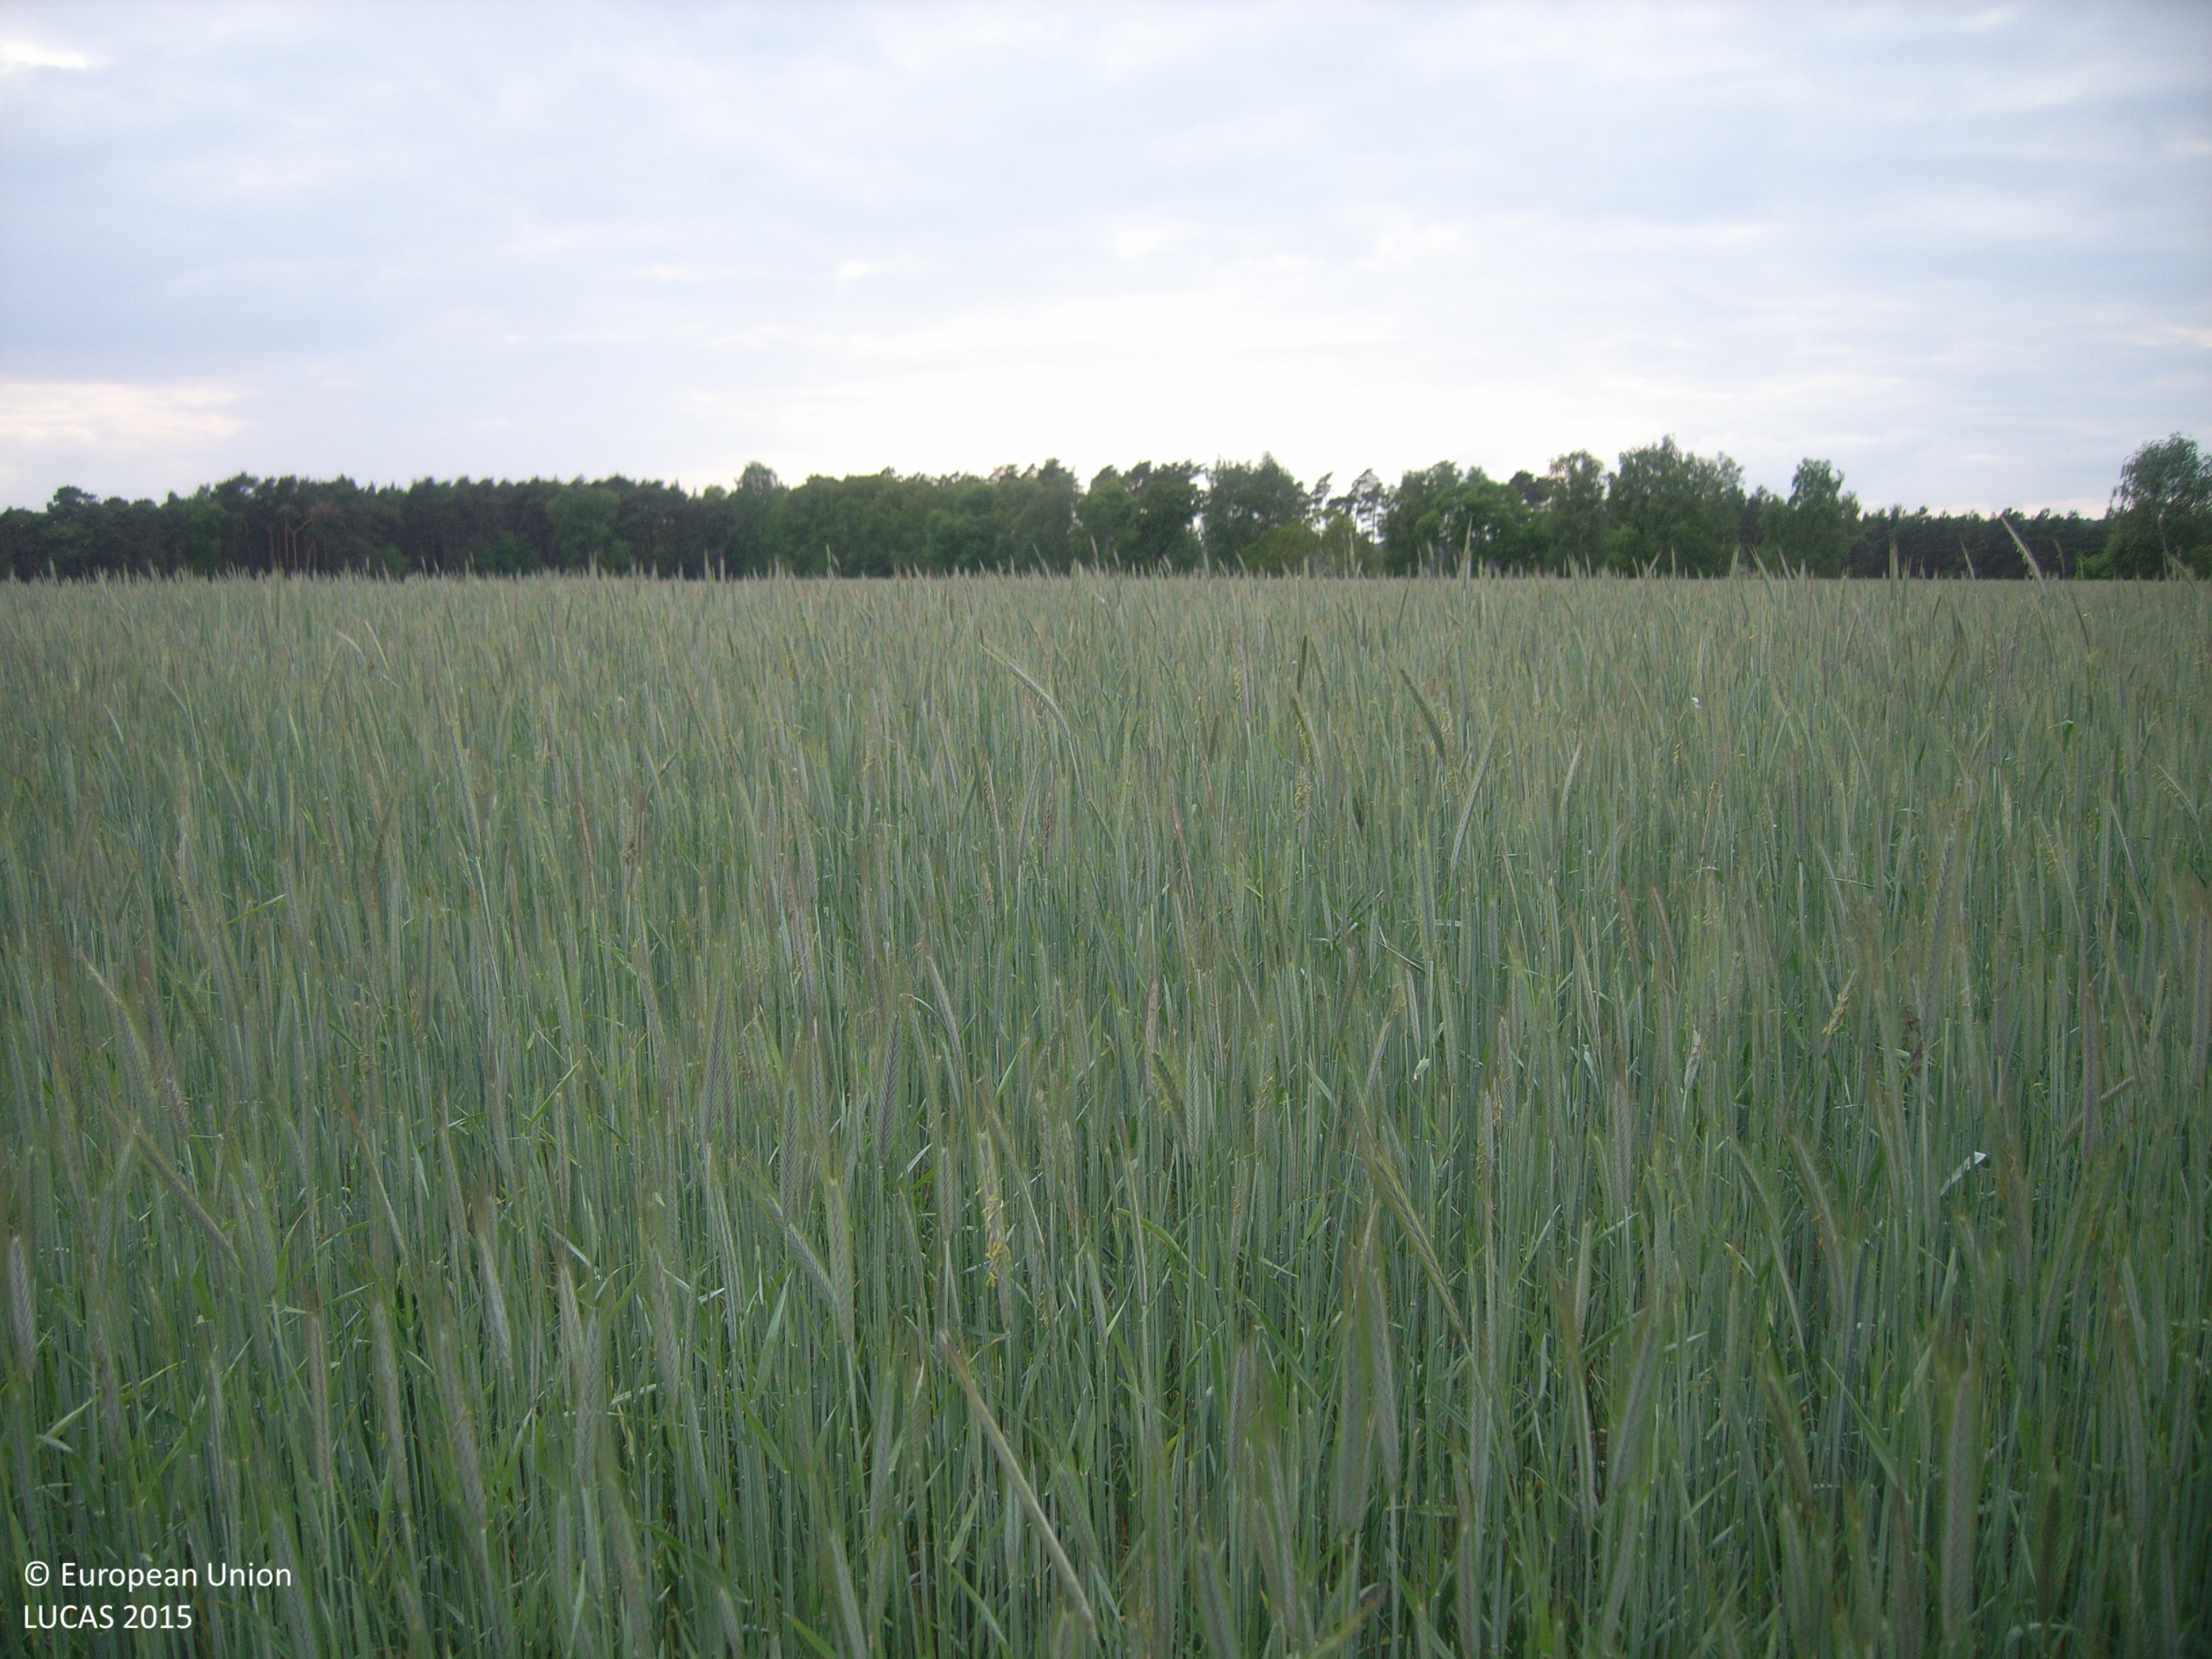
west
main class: Cropland
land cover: Rye
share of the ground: > 75 %
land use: Agriculture (excluding fallow land and kitchen gardens)
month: May
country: DE
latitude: 52.2057
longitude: 14.4061
